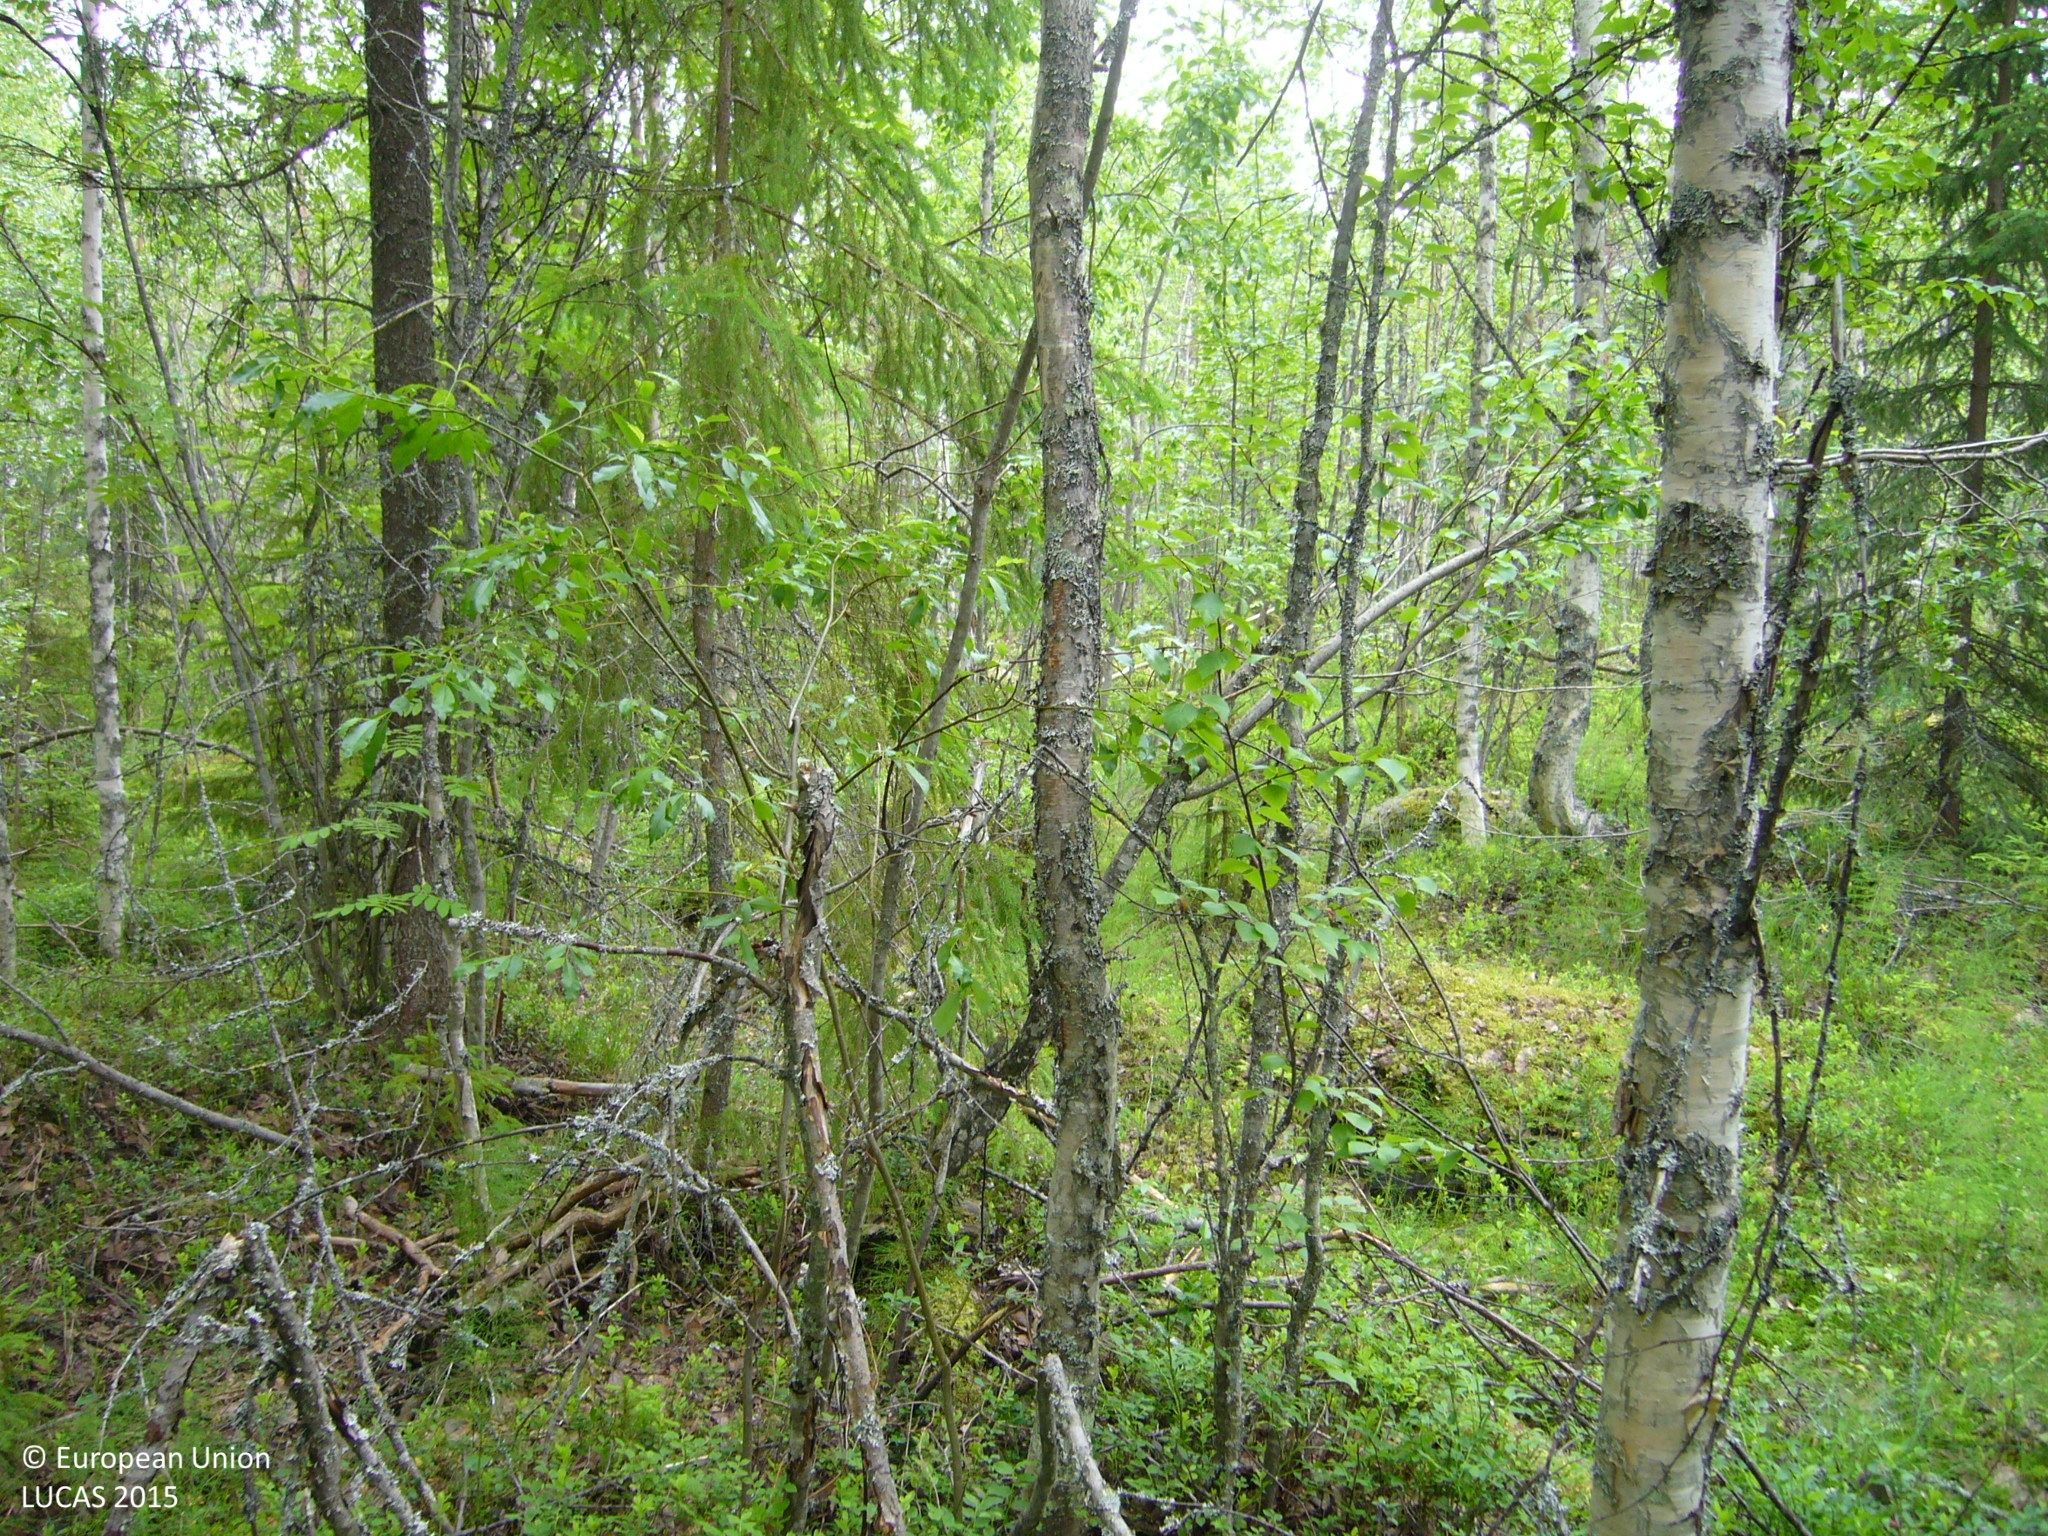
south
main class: Woodland
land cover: Other mixed woodland
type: boreal forest
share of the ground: > 75 %
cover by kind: broadleaved forest trees 55 %, coniferous forest trees 30 %, shrubs 15 %
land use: Forestry
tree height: > 5 m
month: July
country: FI
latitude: 63.4482
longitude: 26.1800
